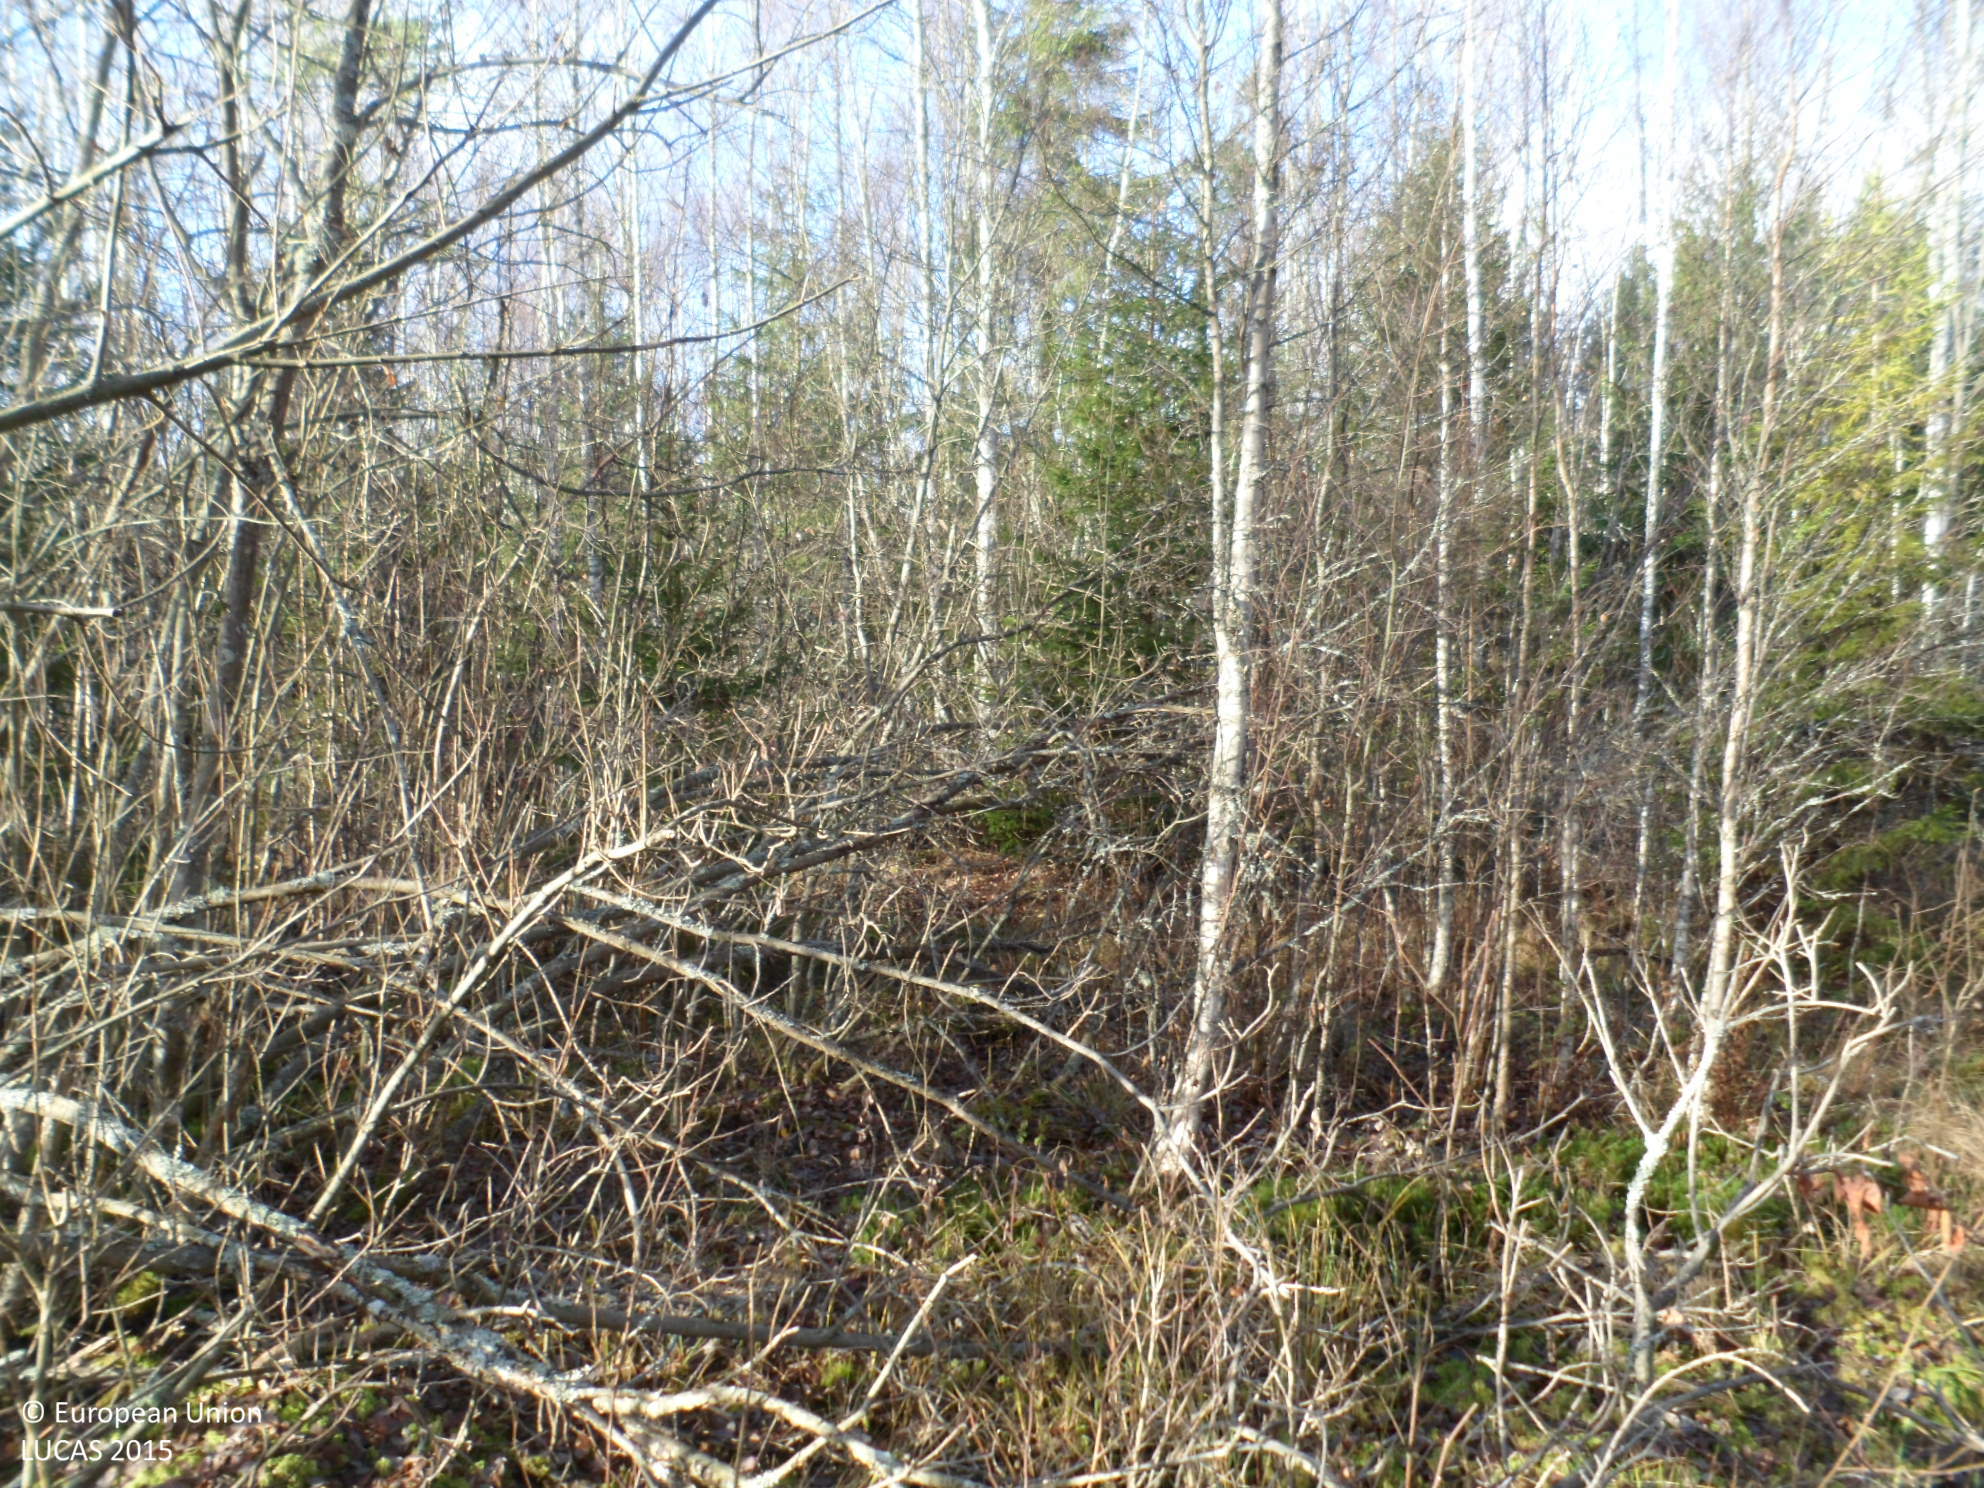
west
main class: Woodland
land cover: Broadleaved woodland
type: boreal forest
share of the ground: 50 - 75 %
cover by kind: broadleaved forest trees 50 %, shrubs 25 %, herbaceous plants 10 %, lichens and mosses 10 %, coniferous forest trees 5 %
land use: Forestry
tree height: > 5 m
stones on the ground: < 10 %
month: November
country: SE
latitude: 57.2310
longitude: 16.1447
